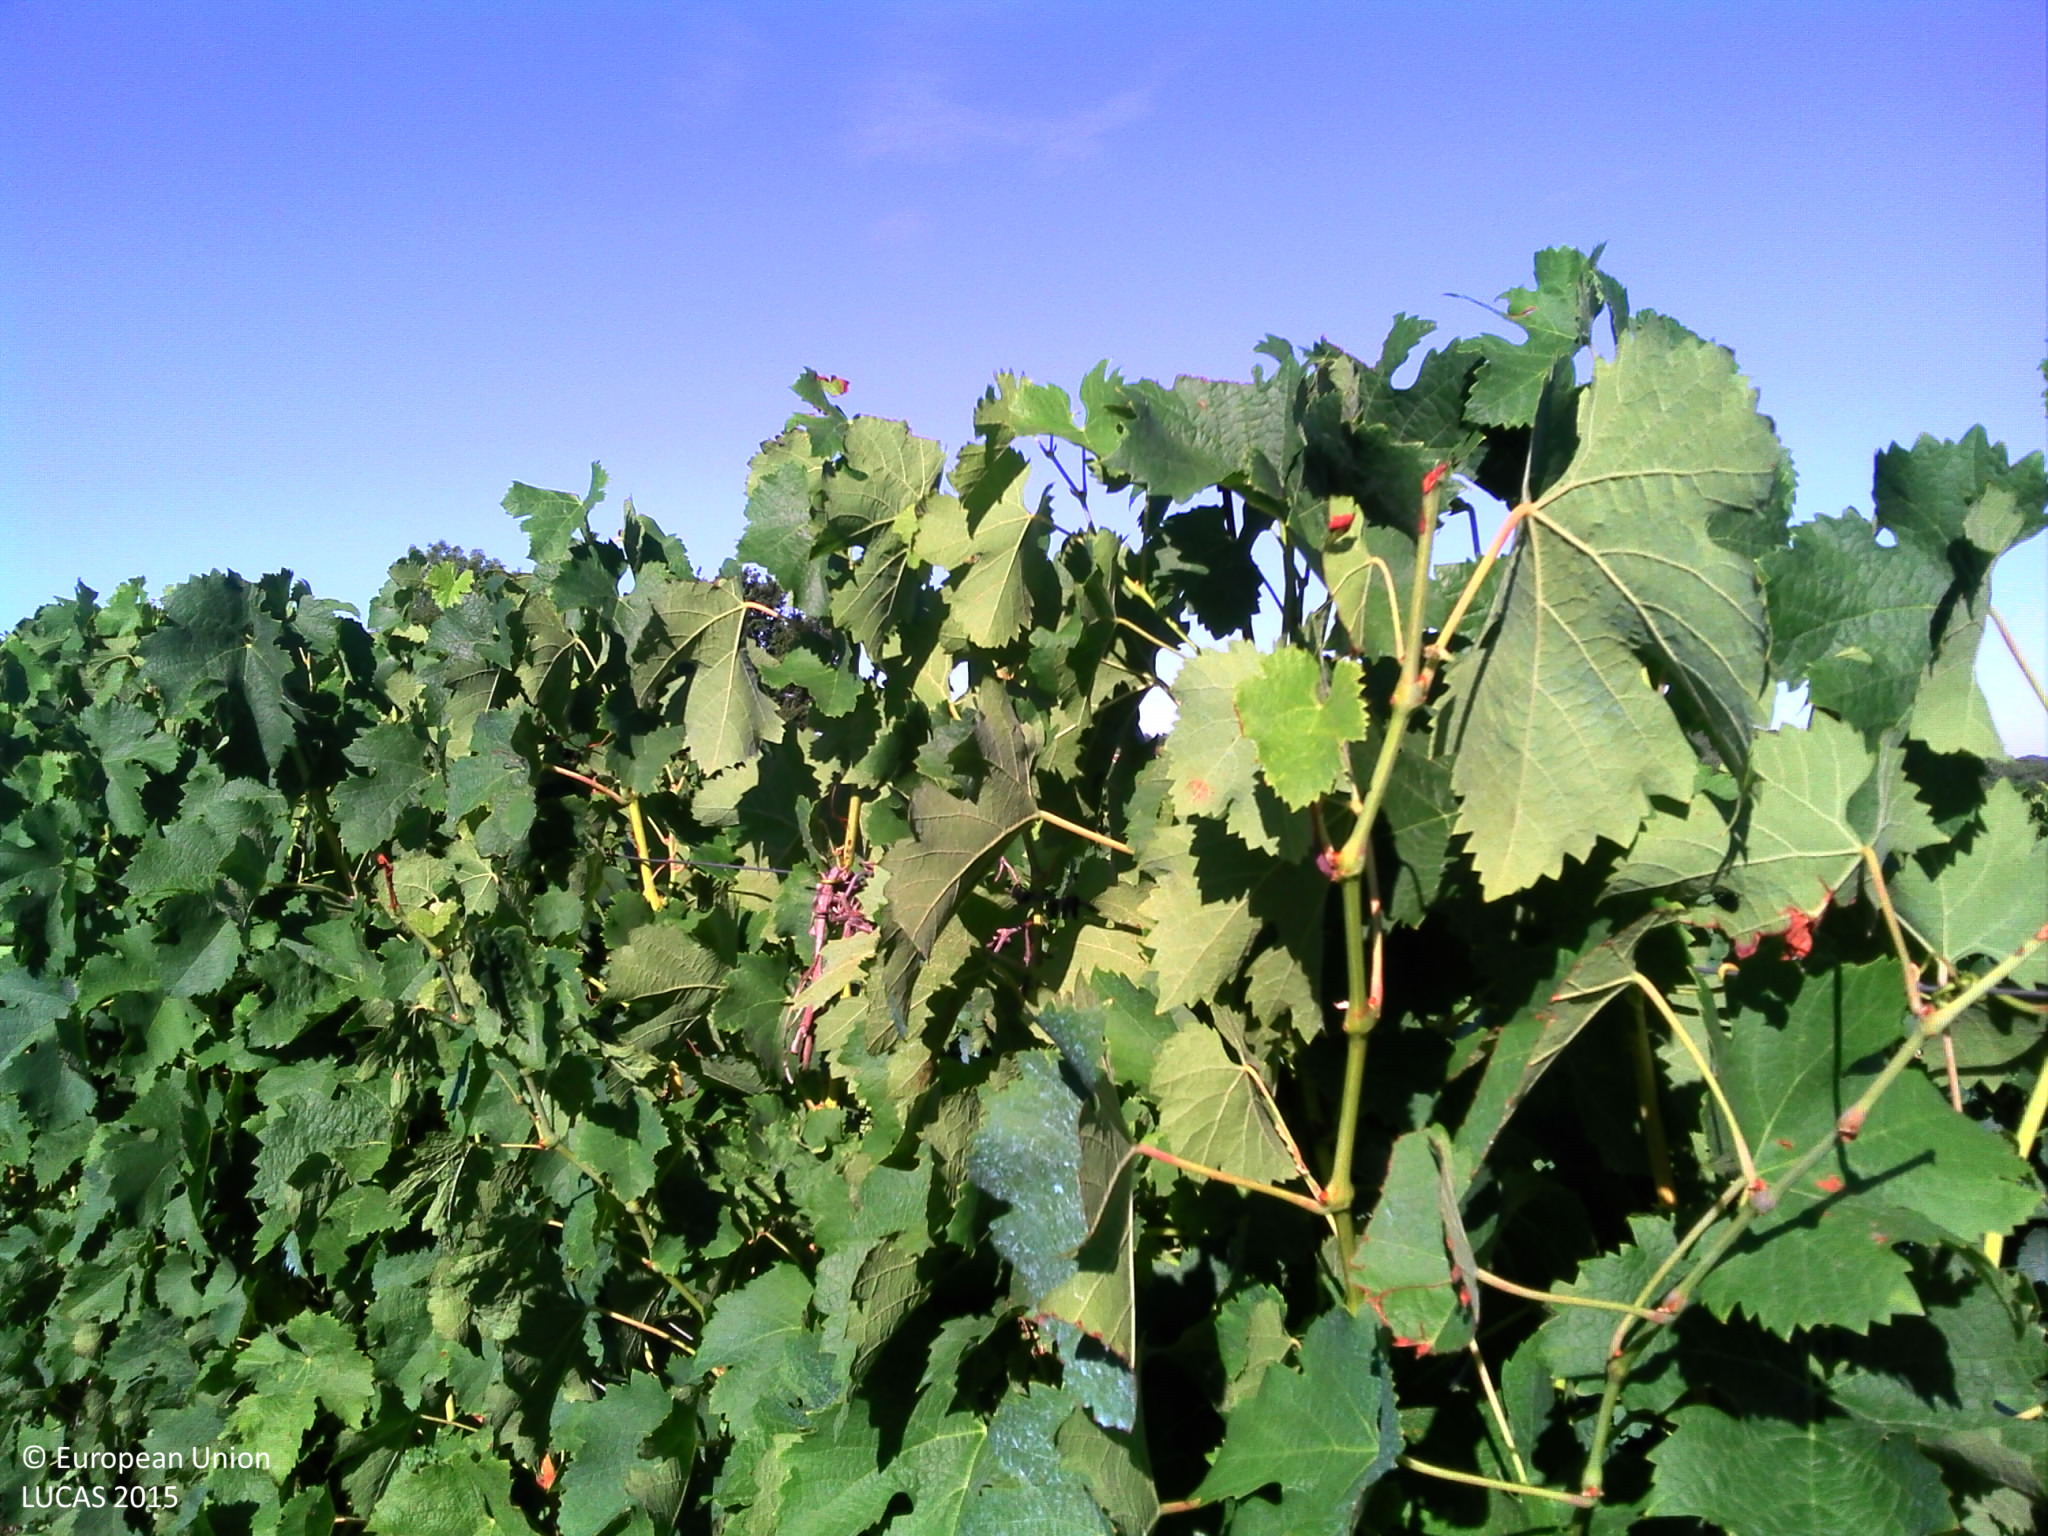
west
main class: Cropland
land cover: Vineyards
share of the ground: 10 - 25 %
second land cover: Grassland without tree/shrub cover
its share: 10 - 25 %
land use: Agriculture (excluding fallow land and kitchen gardens)
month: July
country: FR
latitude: 44.5347
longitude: 0.5414
